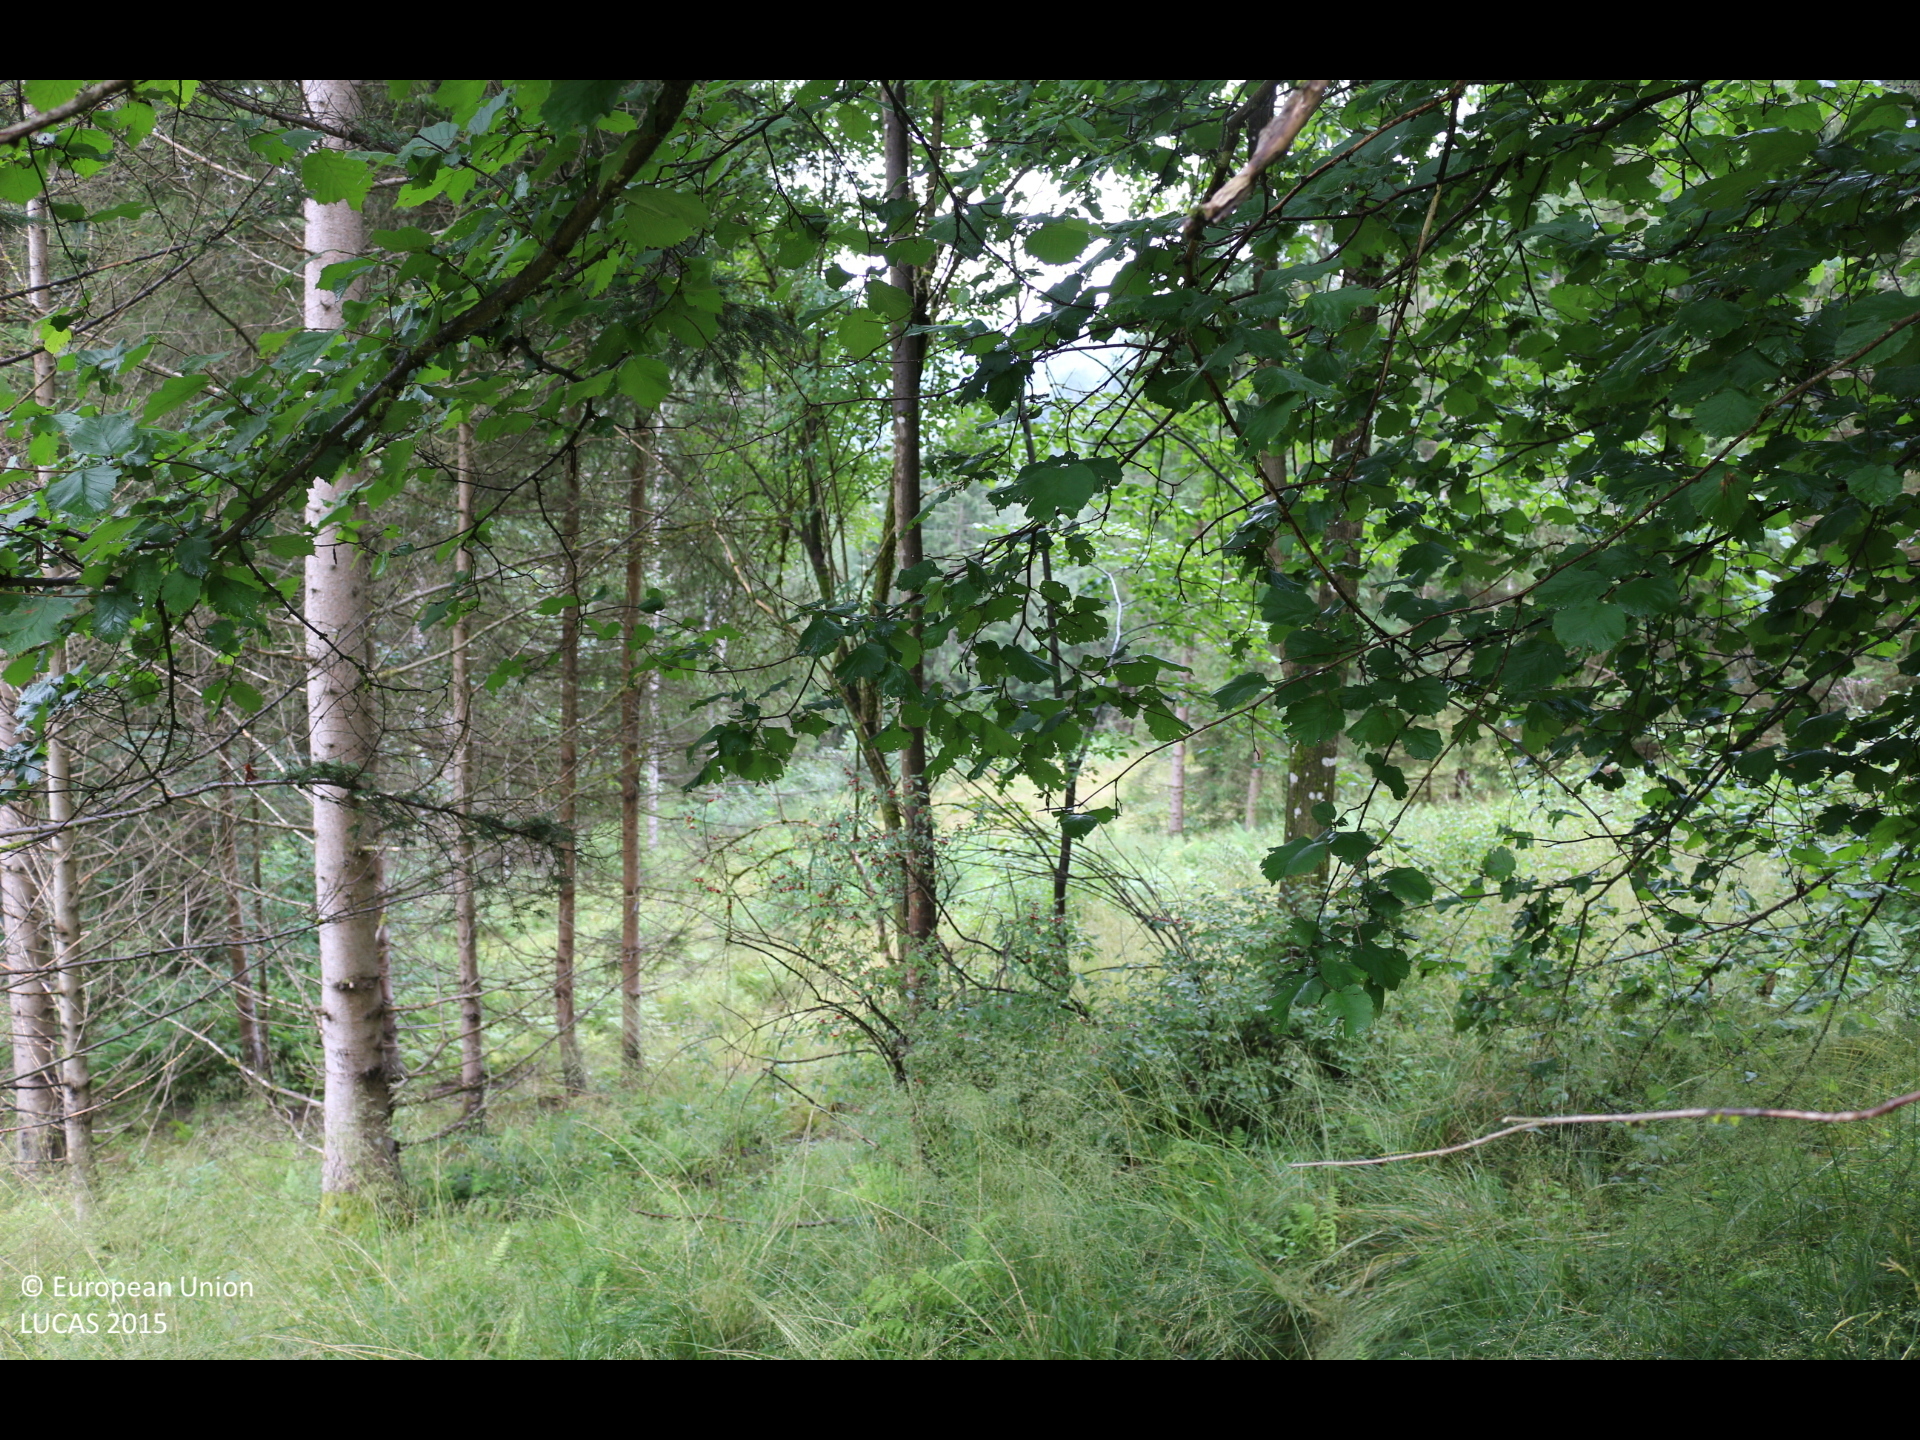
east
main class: Woodland
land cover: Spruce dominated mixed woodland
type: mountainous beech forest
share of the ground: > 75 %
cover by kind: coniferous forest trees 65 %, broadleaved forest trees 25 %, shrubs 5 %, herbaceous plants 5 %
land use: Forestry
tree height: > 5 m
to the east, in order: Spruce dominated mixed woodland; Shrubland without tree cover; Spontaneously vegetated surfaces; Tracks; Shrubland without tree cover; Grassland without tree/shrub cover; Spruce dominated mixed woodland; Fences; Tracks; Fences; Grassland without tree/shrub cover; Broadleaved woodland
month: July
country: AT
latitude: 46.9682
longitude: 14.2959
